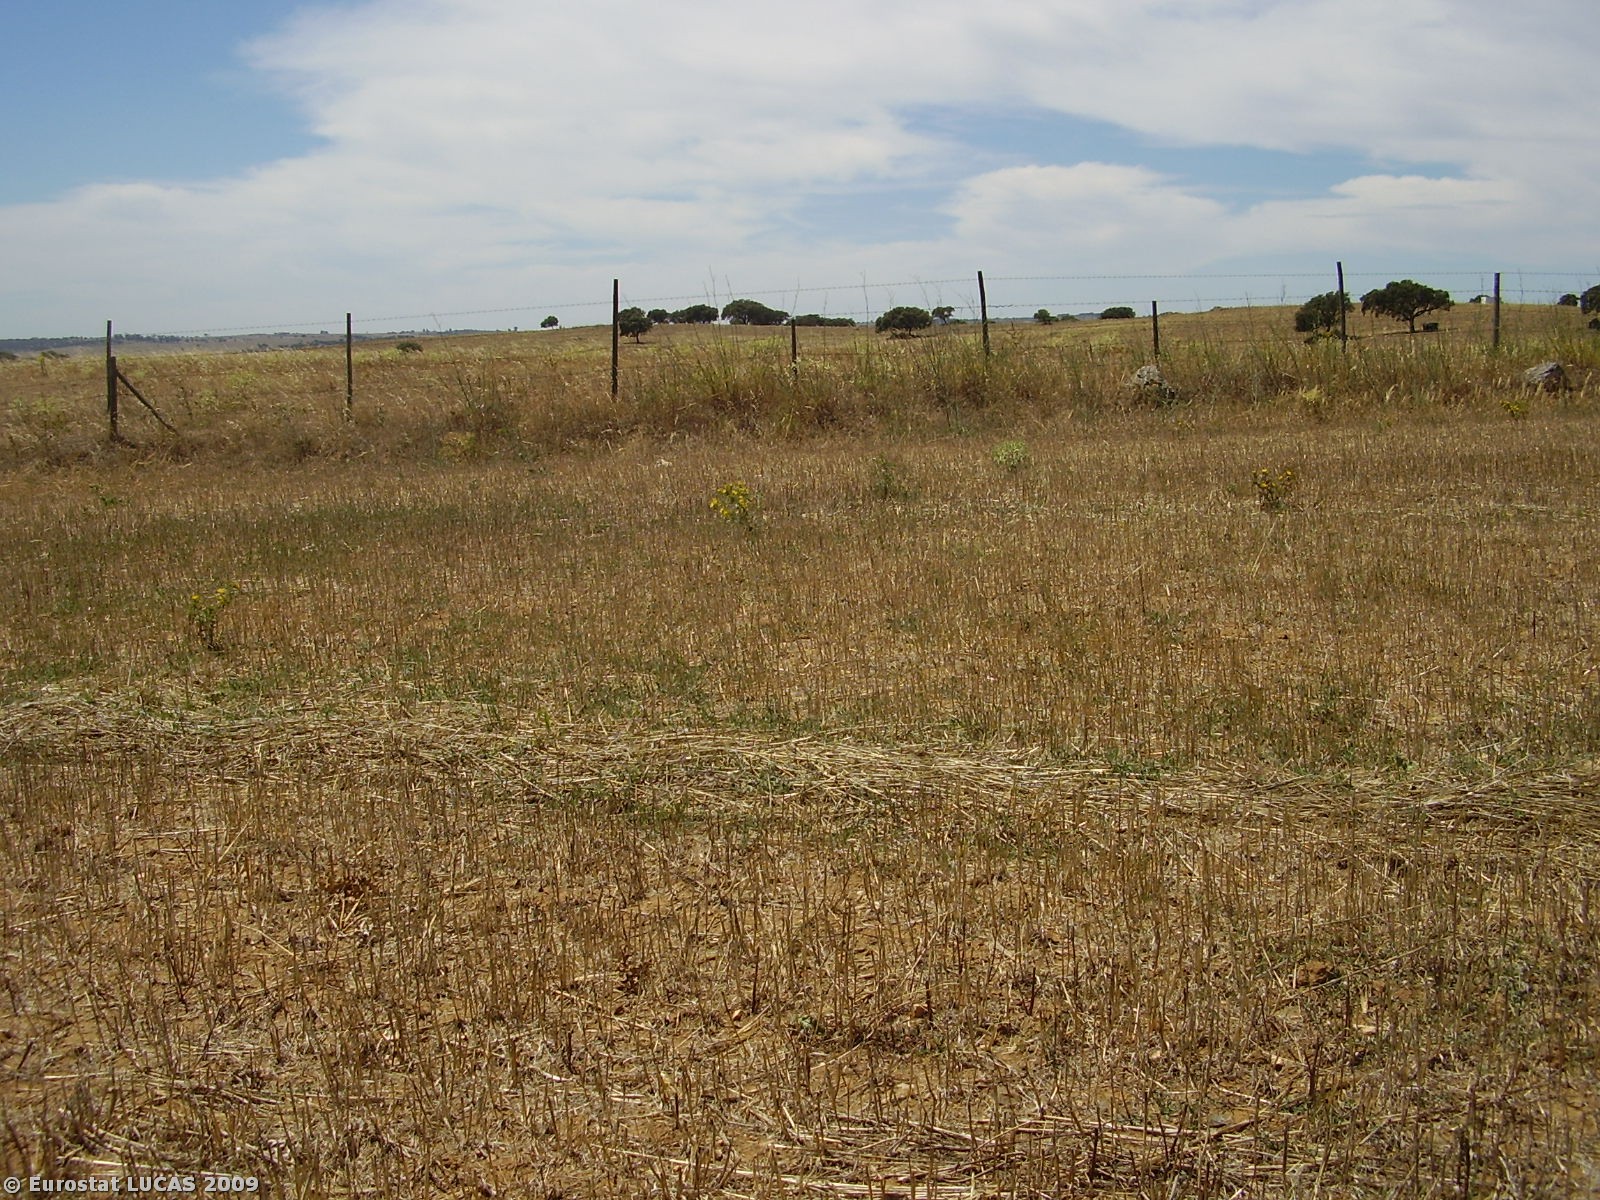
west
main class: Cropland
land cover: Common wheat
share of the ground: > 75 %
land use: Agriculture (excluding fallow land and kitchen gardens)
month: July
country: PT
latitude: 38.6811
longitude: -7.8934
